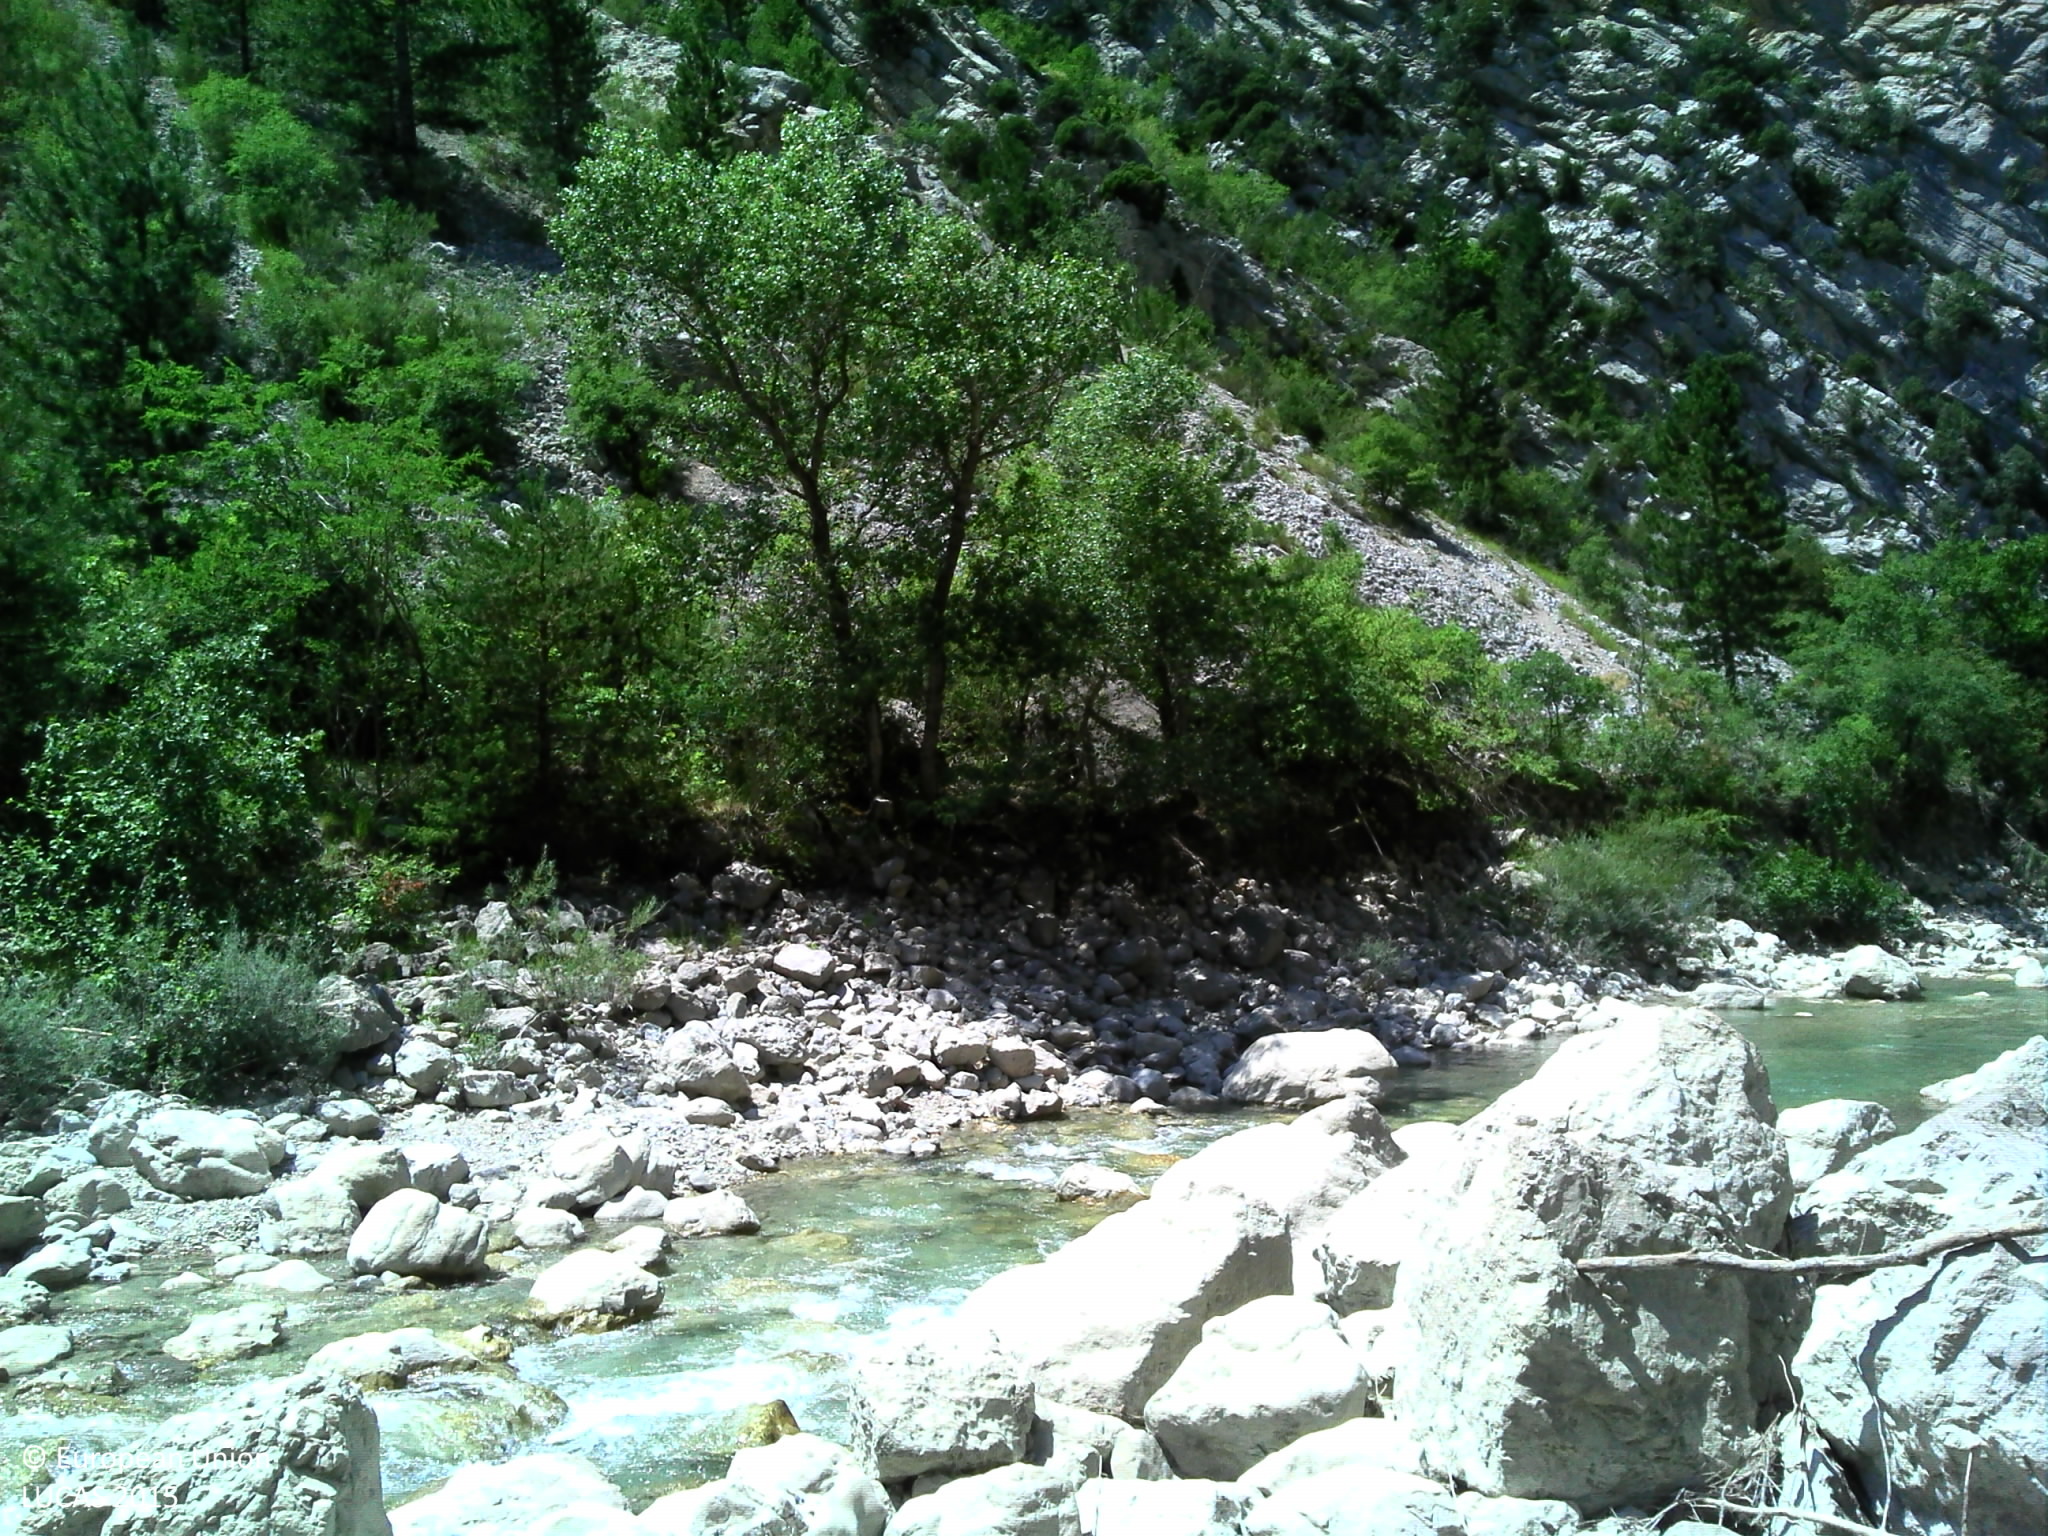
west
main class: Woodland
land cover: Broadleaved woodland
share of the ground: 50 - 75 %
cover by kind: unconsolidated bare surface 50 %, broadleaved forest trees 40 %, herbaceous plants 10 %
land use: Semi-natural and natural areas not in use
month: July
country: FR
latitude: 44.0121
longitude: 6.2532
